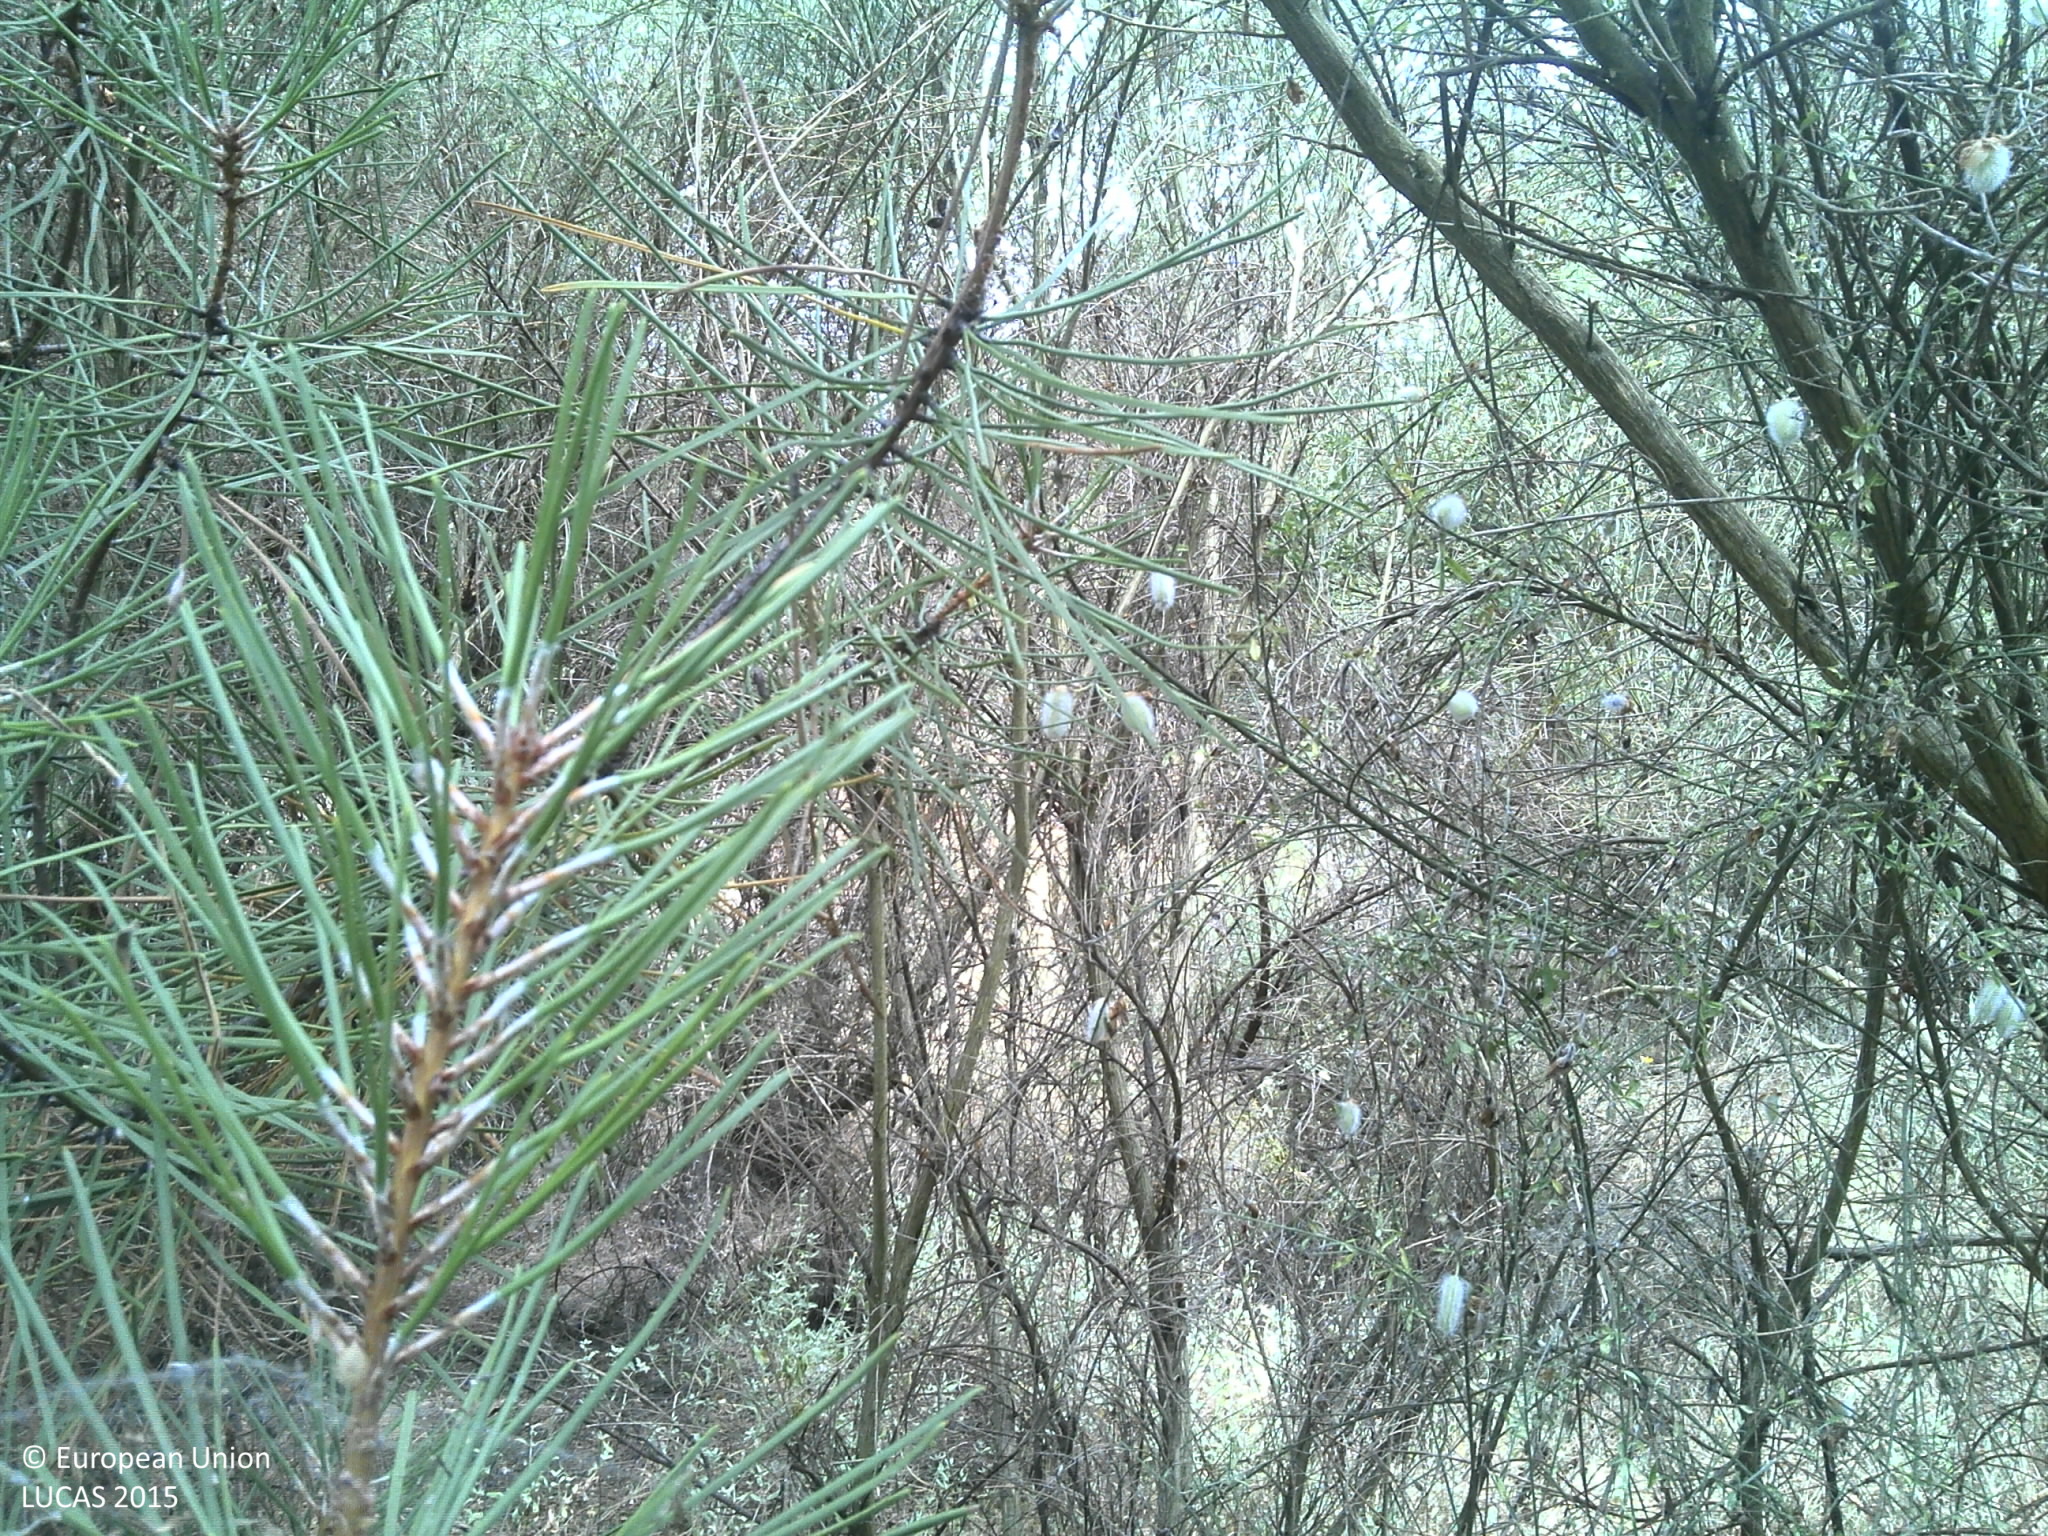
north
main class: Woodland
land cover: Pine dominated coniferous woodland
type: coniferous forest of the mediterranean region
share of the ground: 10 - 25 %
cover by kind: shrubs 60 %, coniferous forest trees 20 %, unconsolidated bare surface 15 %
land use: Forestry
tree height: > 5 m
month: July
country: PT
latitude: 40.9890
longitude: -7.3873
